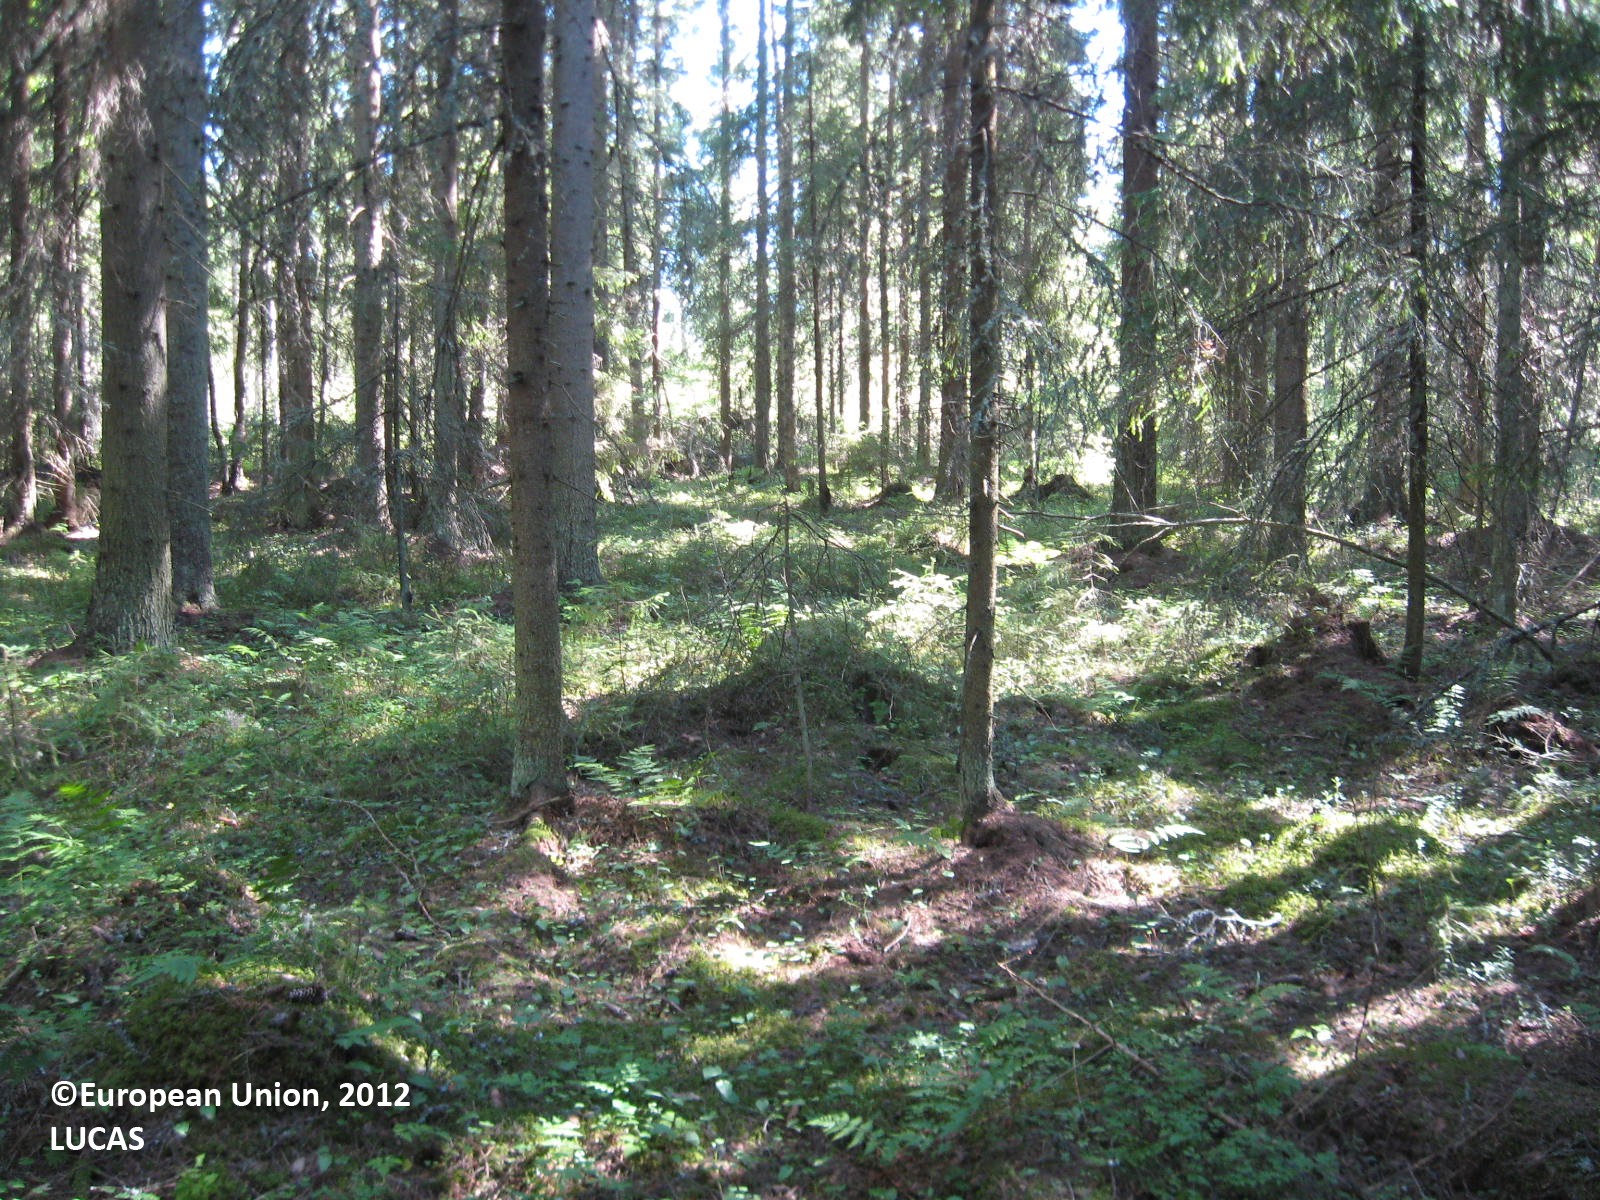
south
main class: Woodland
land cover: Spruce dominated coniferous woodland
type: boreal forest
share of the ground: > 75 %
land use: Forestry
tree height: > 5 m
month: July
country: FI
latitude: 62.1933
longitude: 21.6730
